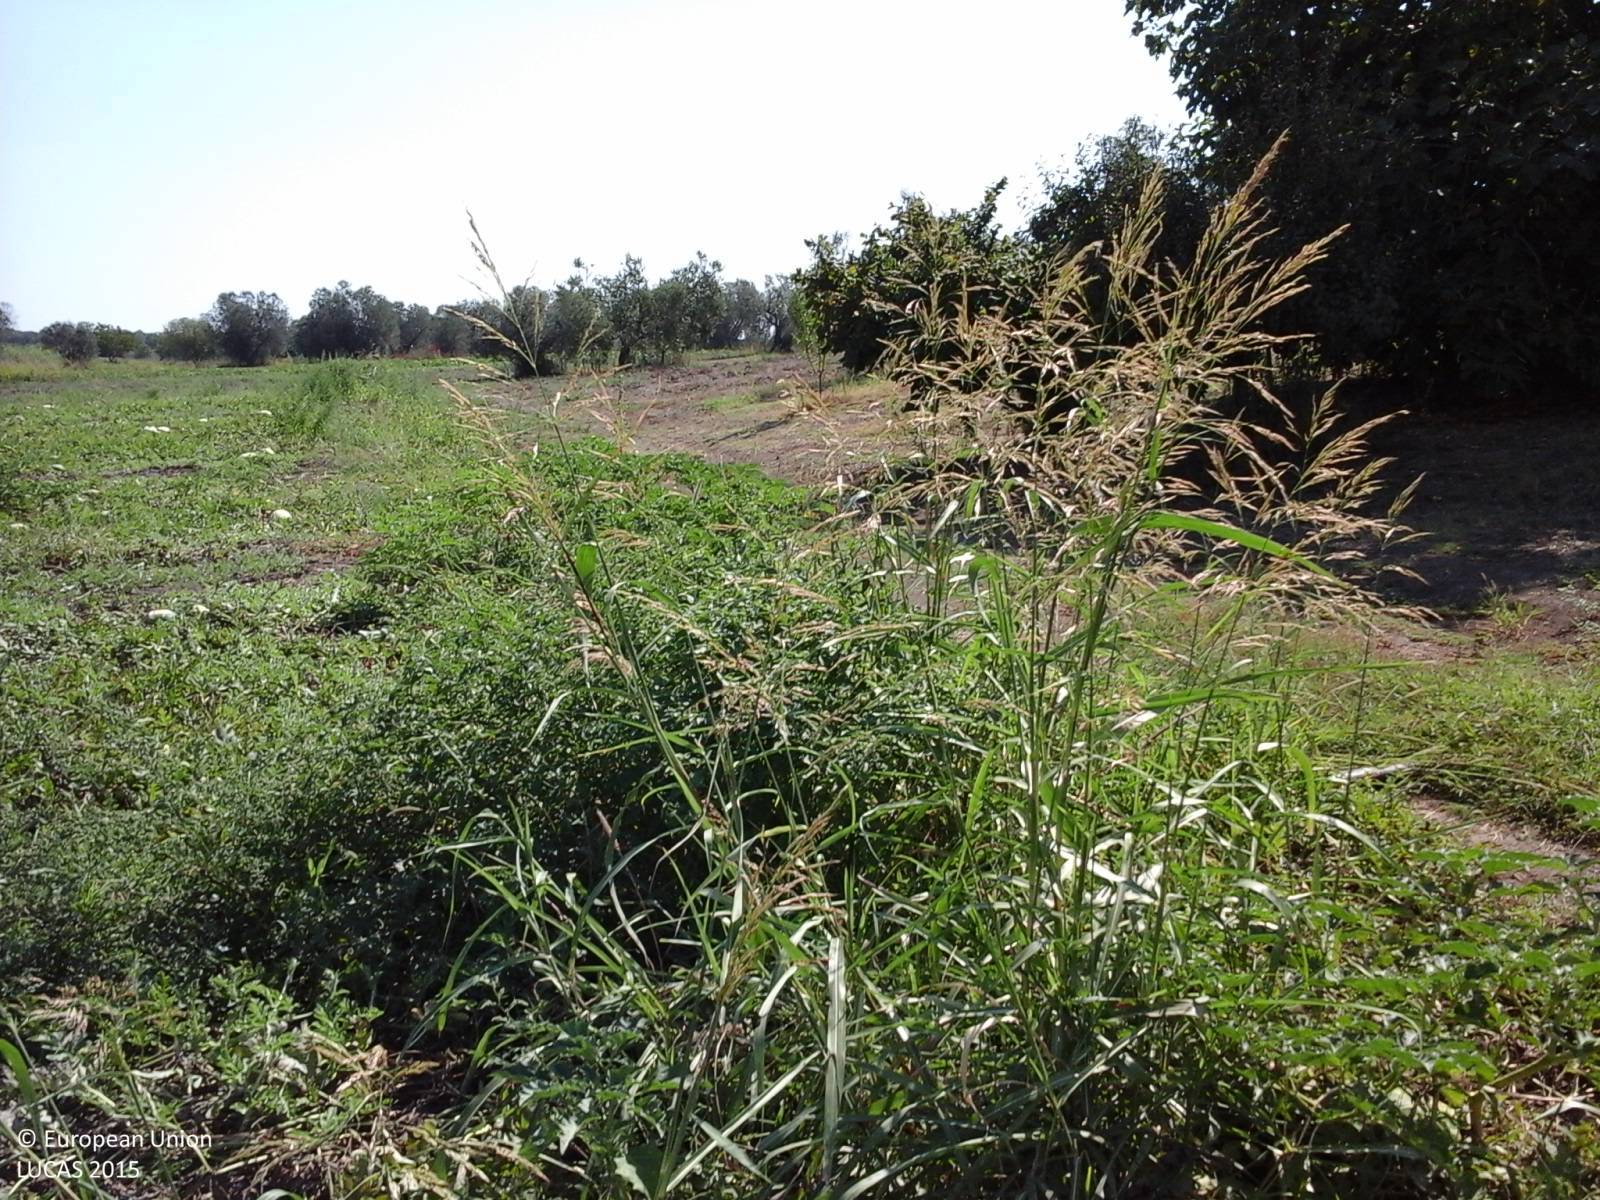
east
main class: Cropland
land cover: Other fresh vegetables
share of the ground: > 75 %
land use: Agriculture (excluding fallow land and kitchen gardens)
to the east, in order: Other fresh vegetables; Tracks; Other bare soil; Olive groves; Other bare soil; Olive groves; Other bare soil; Other fresh vegetables; Olive groves; Other fresh vegetables; Olive groves; Other fresh vegetables; Olive groves; Other fresh vegetables; Olive groves; Other fresh vegetables; Olive groves; Other fresh vegetables
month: August
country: IT
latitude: 42.4056
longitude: 11.6588
